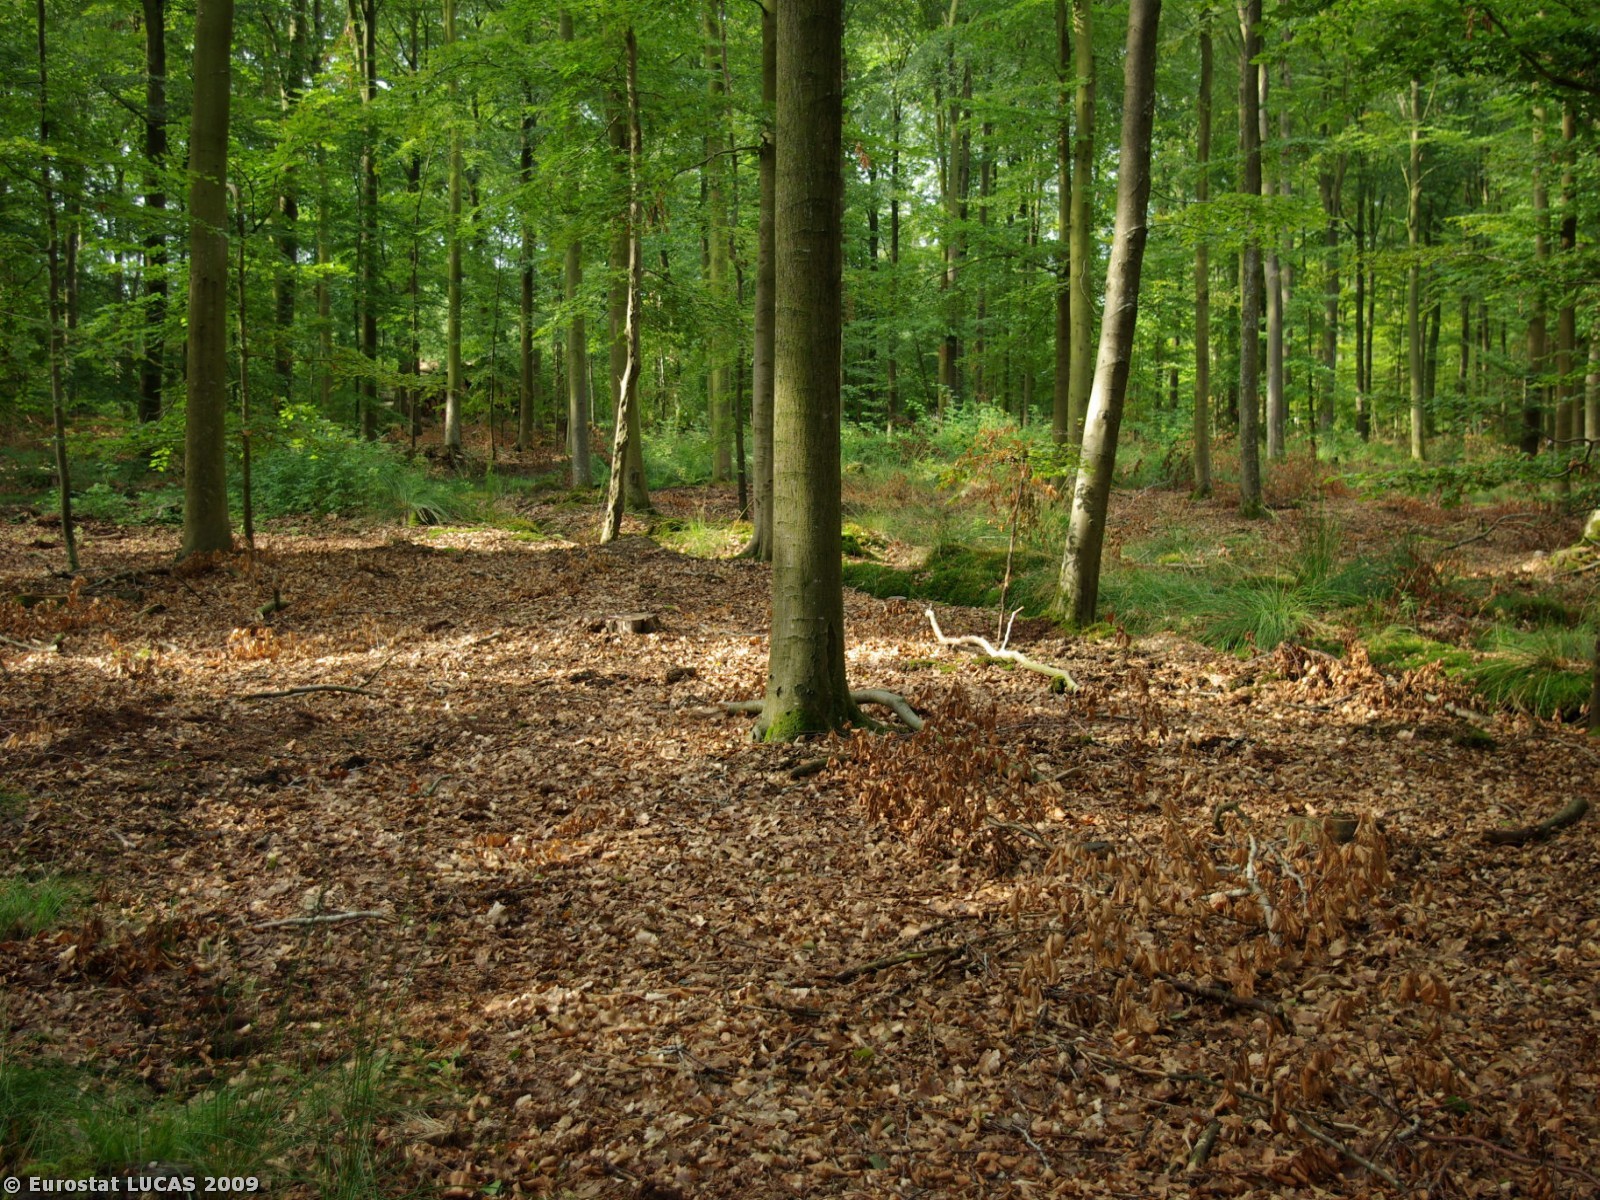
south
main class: Woodland
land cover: Broadleaved woodland
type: beech forest
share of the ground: > 75 %
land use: Forestry
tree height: > 5 m
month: July
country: DK
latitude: 54.9600
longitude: 8.8296
